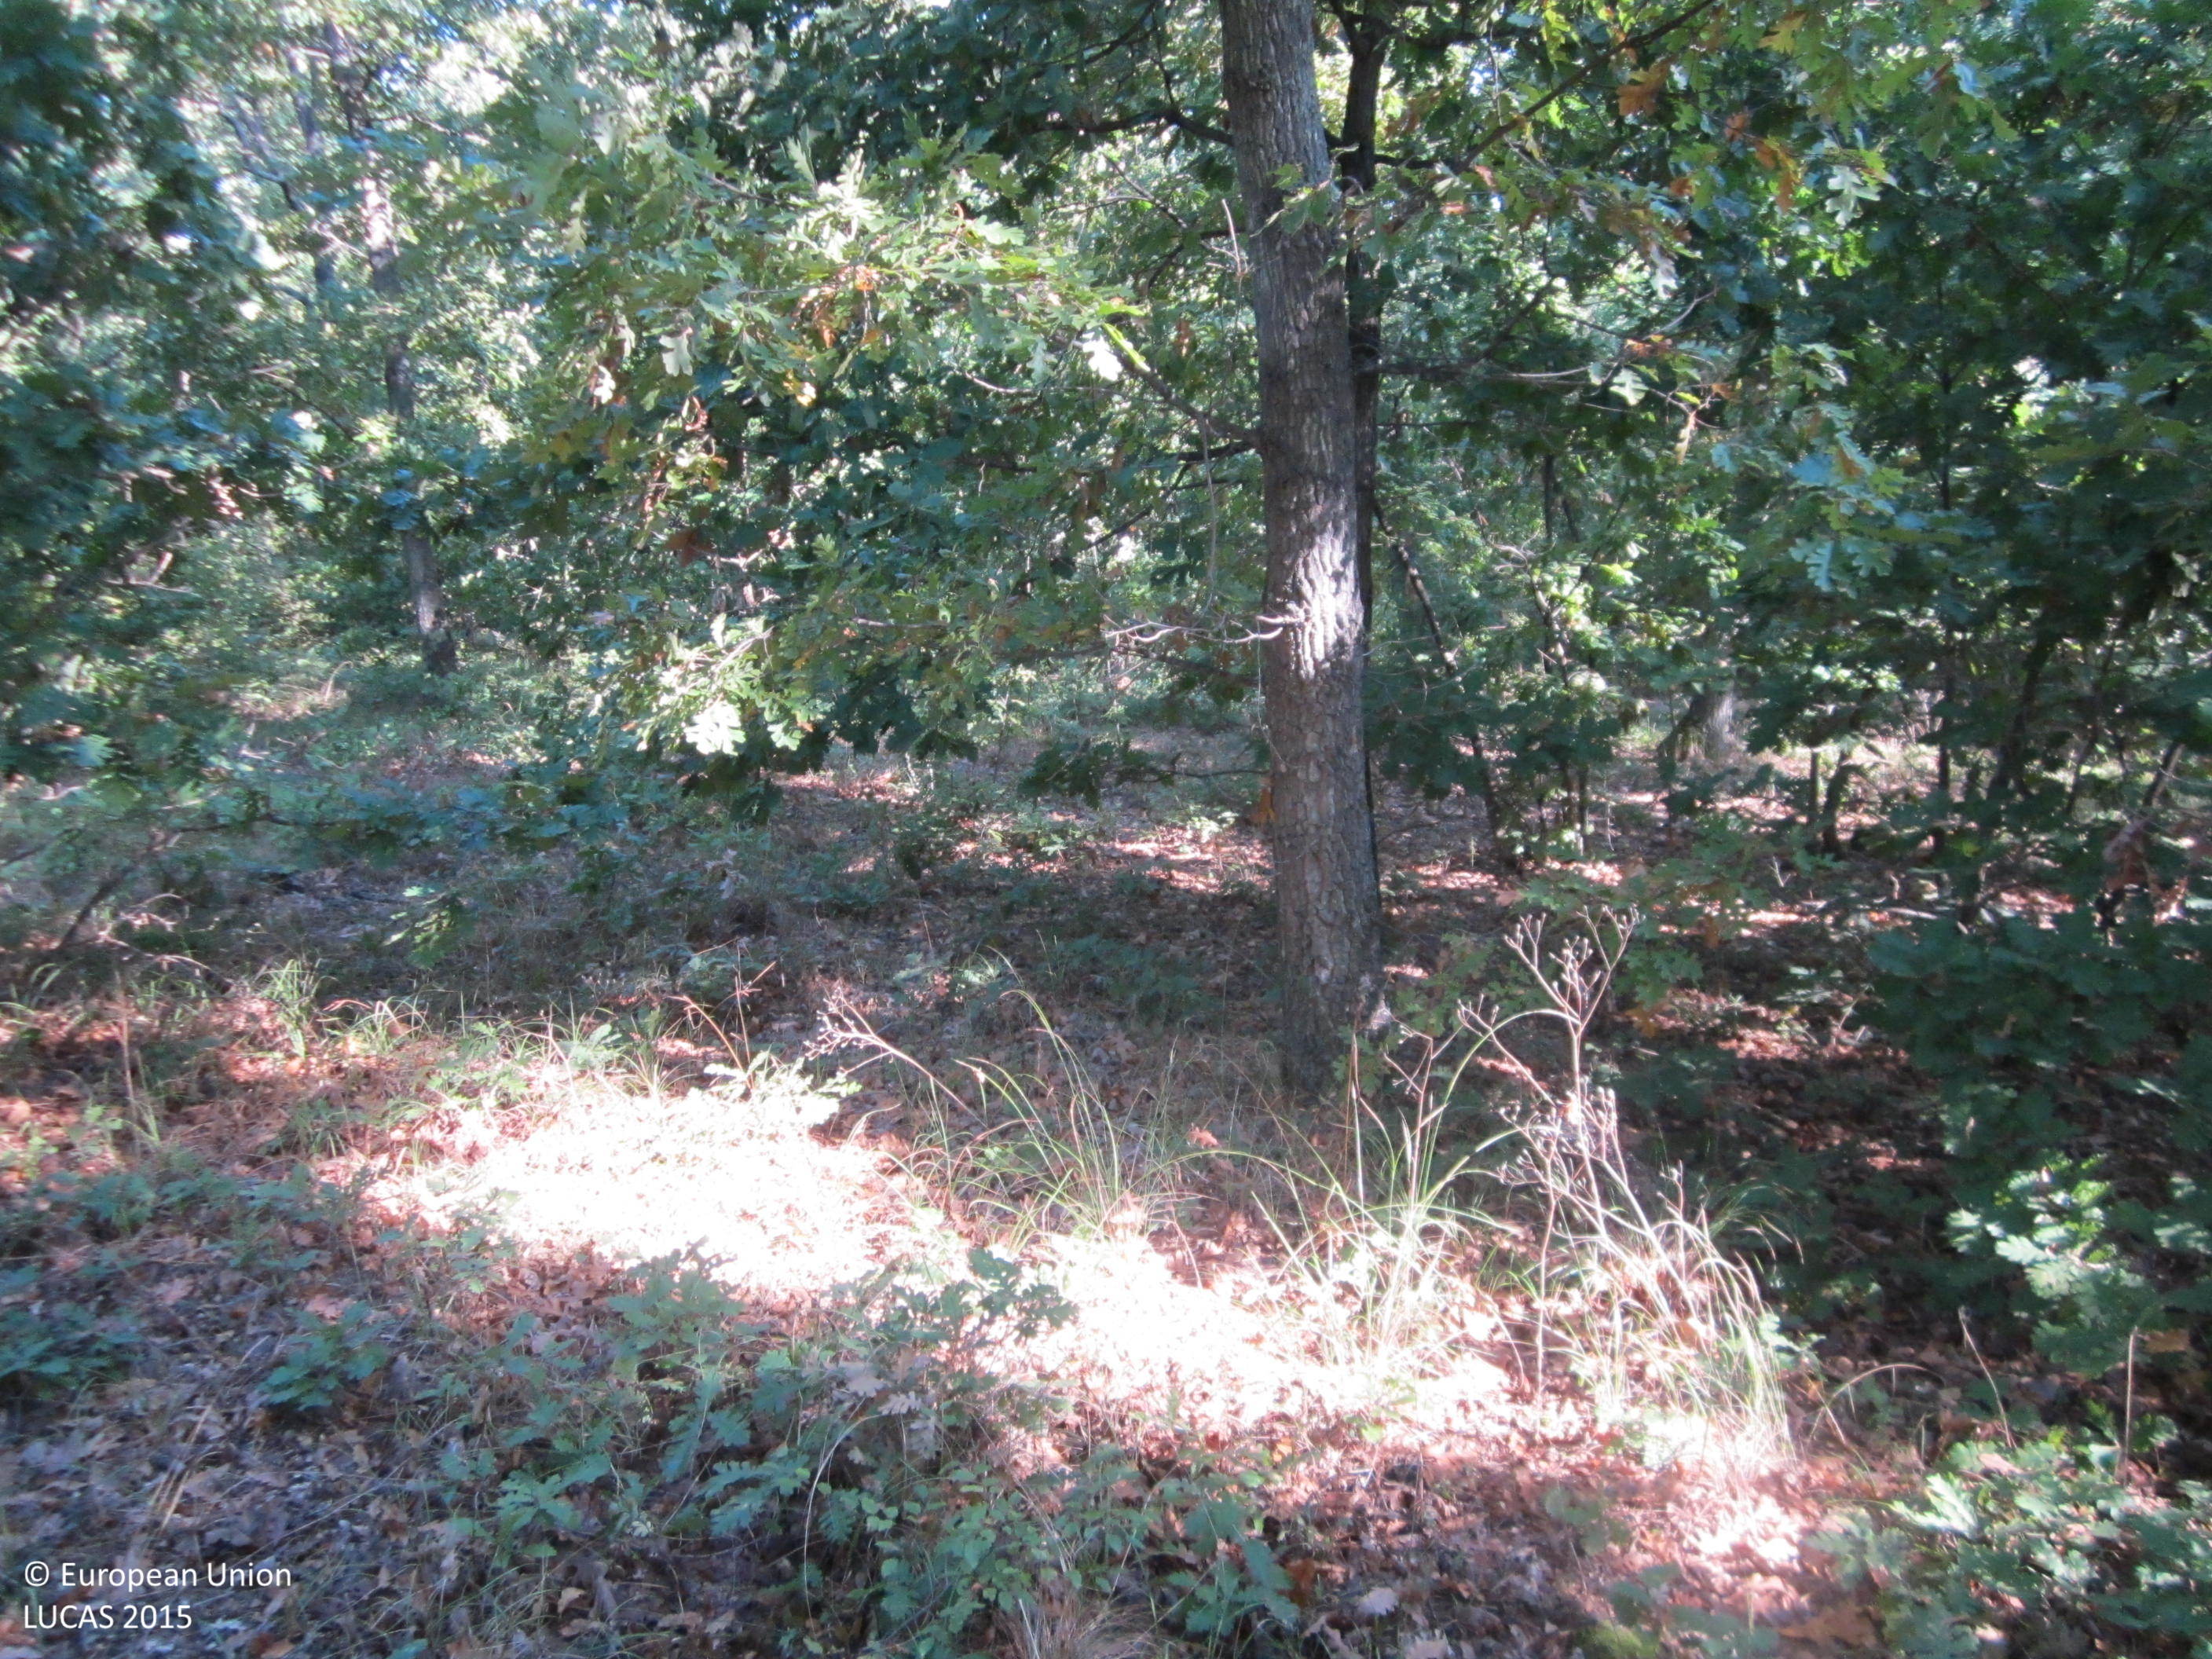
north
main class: Woodland
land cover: Broadleaved woodland
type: thermophilous deciduous forest
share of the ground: 50 - 75 %
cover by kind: broadleaved forest trees 65 %, herbaceous plants 30 %, lichens and mosses 5 %
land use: Forestry
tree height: > 5 m
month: September
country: BG
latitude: 42.3693
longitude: 27.2932
